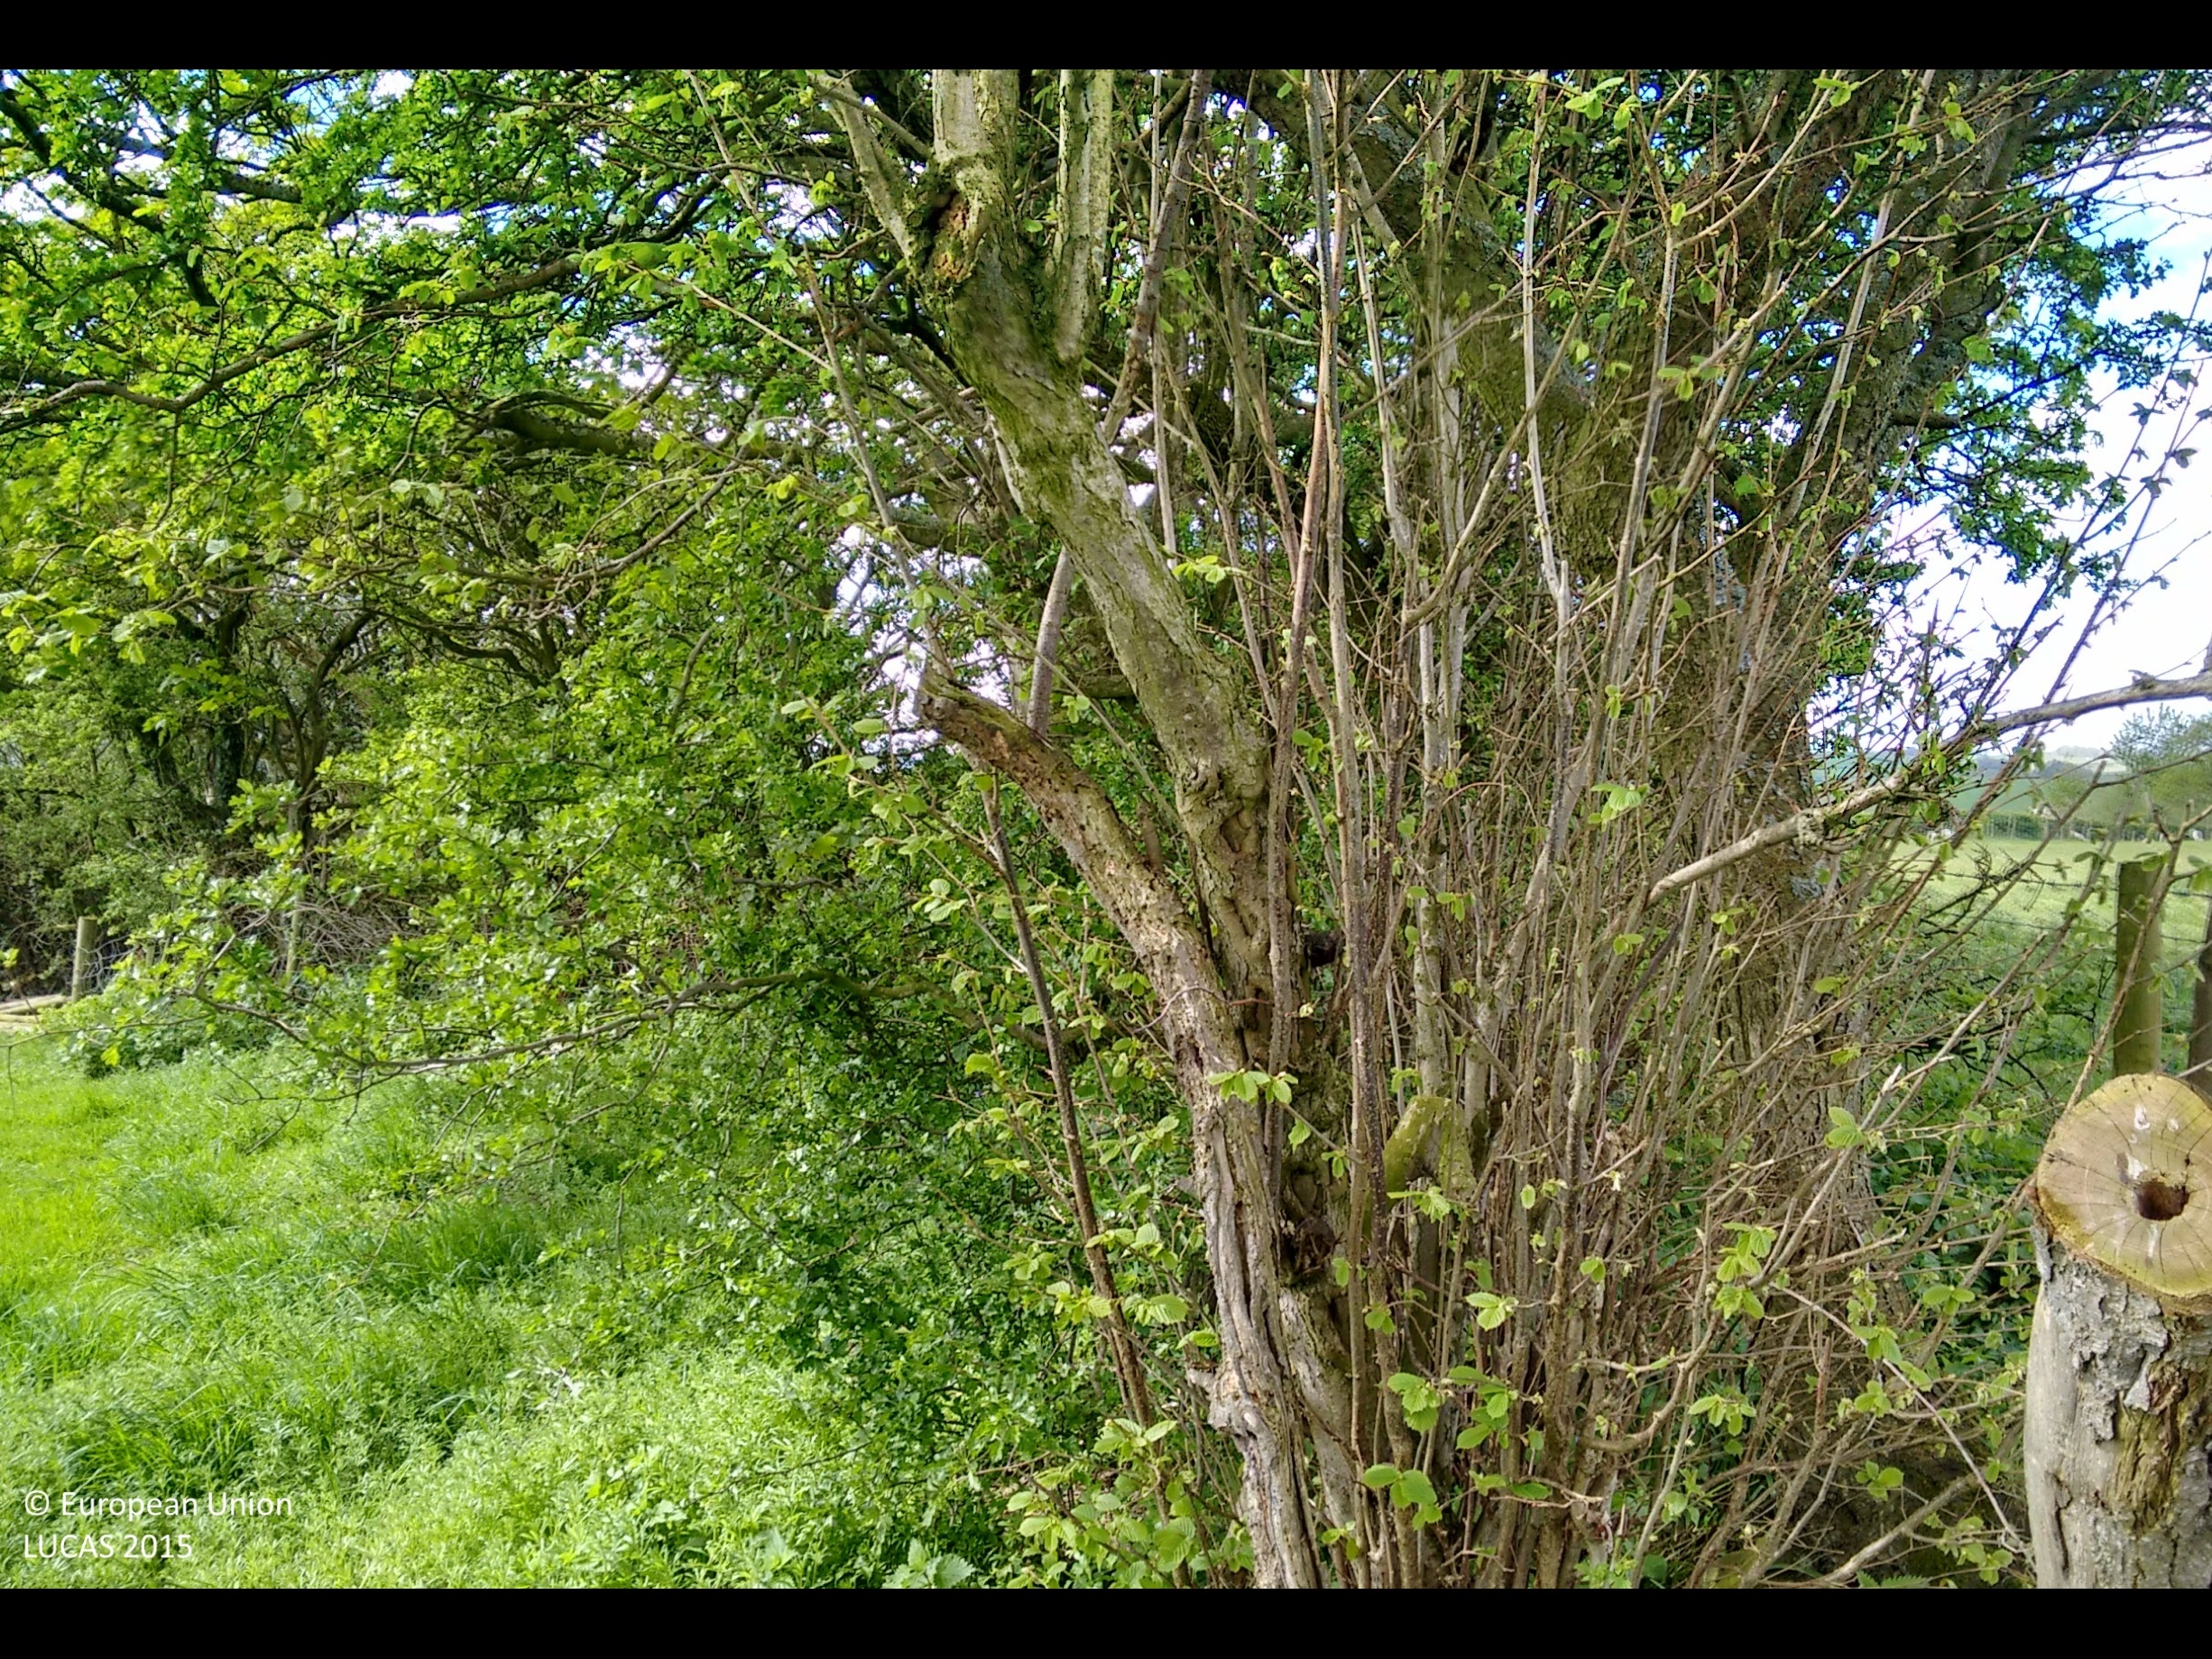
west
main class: Grassland
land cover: Grassland without tree/shrub cover
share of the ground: > 75 %
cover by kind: herbaceous plants 100 %
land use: Agriculture (excluding fallow land and kitchen gardens)
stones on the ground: < 10 %
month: May
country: GB
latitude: 54.1184
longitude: -2.6584
